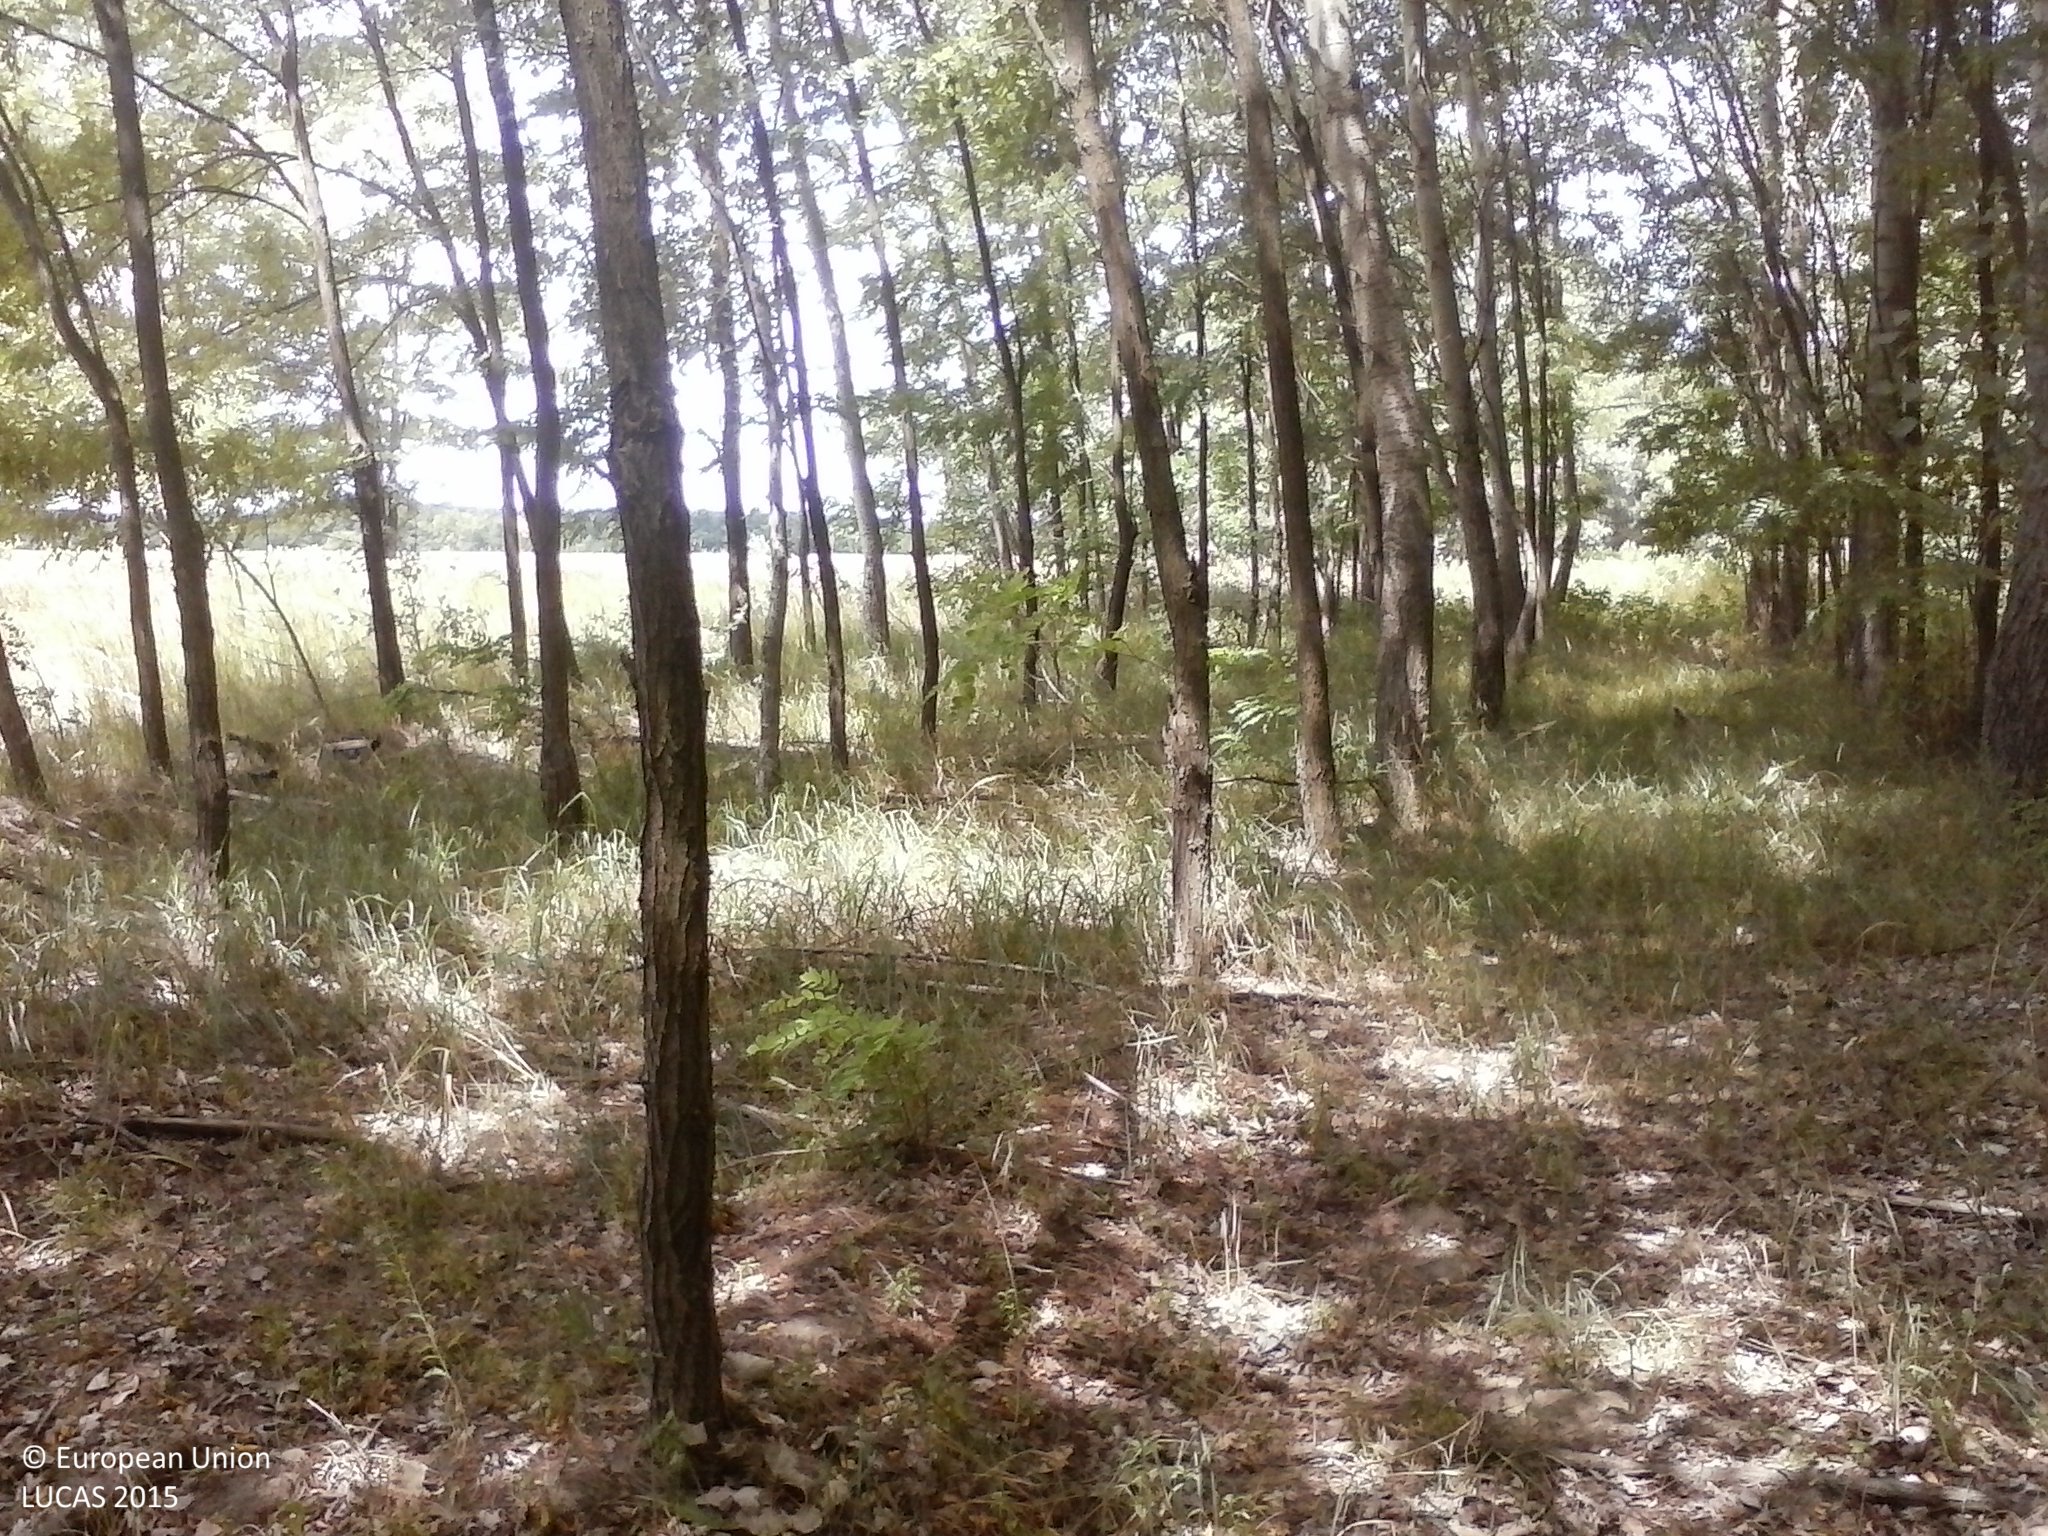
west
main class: Woodland
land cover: Broadleaved woodland
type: mesophytic deciduous forest
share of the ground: > 75 %
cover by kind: broadleaved forest trees 90 %, shrubs 5 %, herbaceous plants 5 %
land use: Forestry
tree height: > 5 m
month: July
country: HU
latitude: 46.6015
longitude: 19.6665
